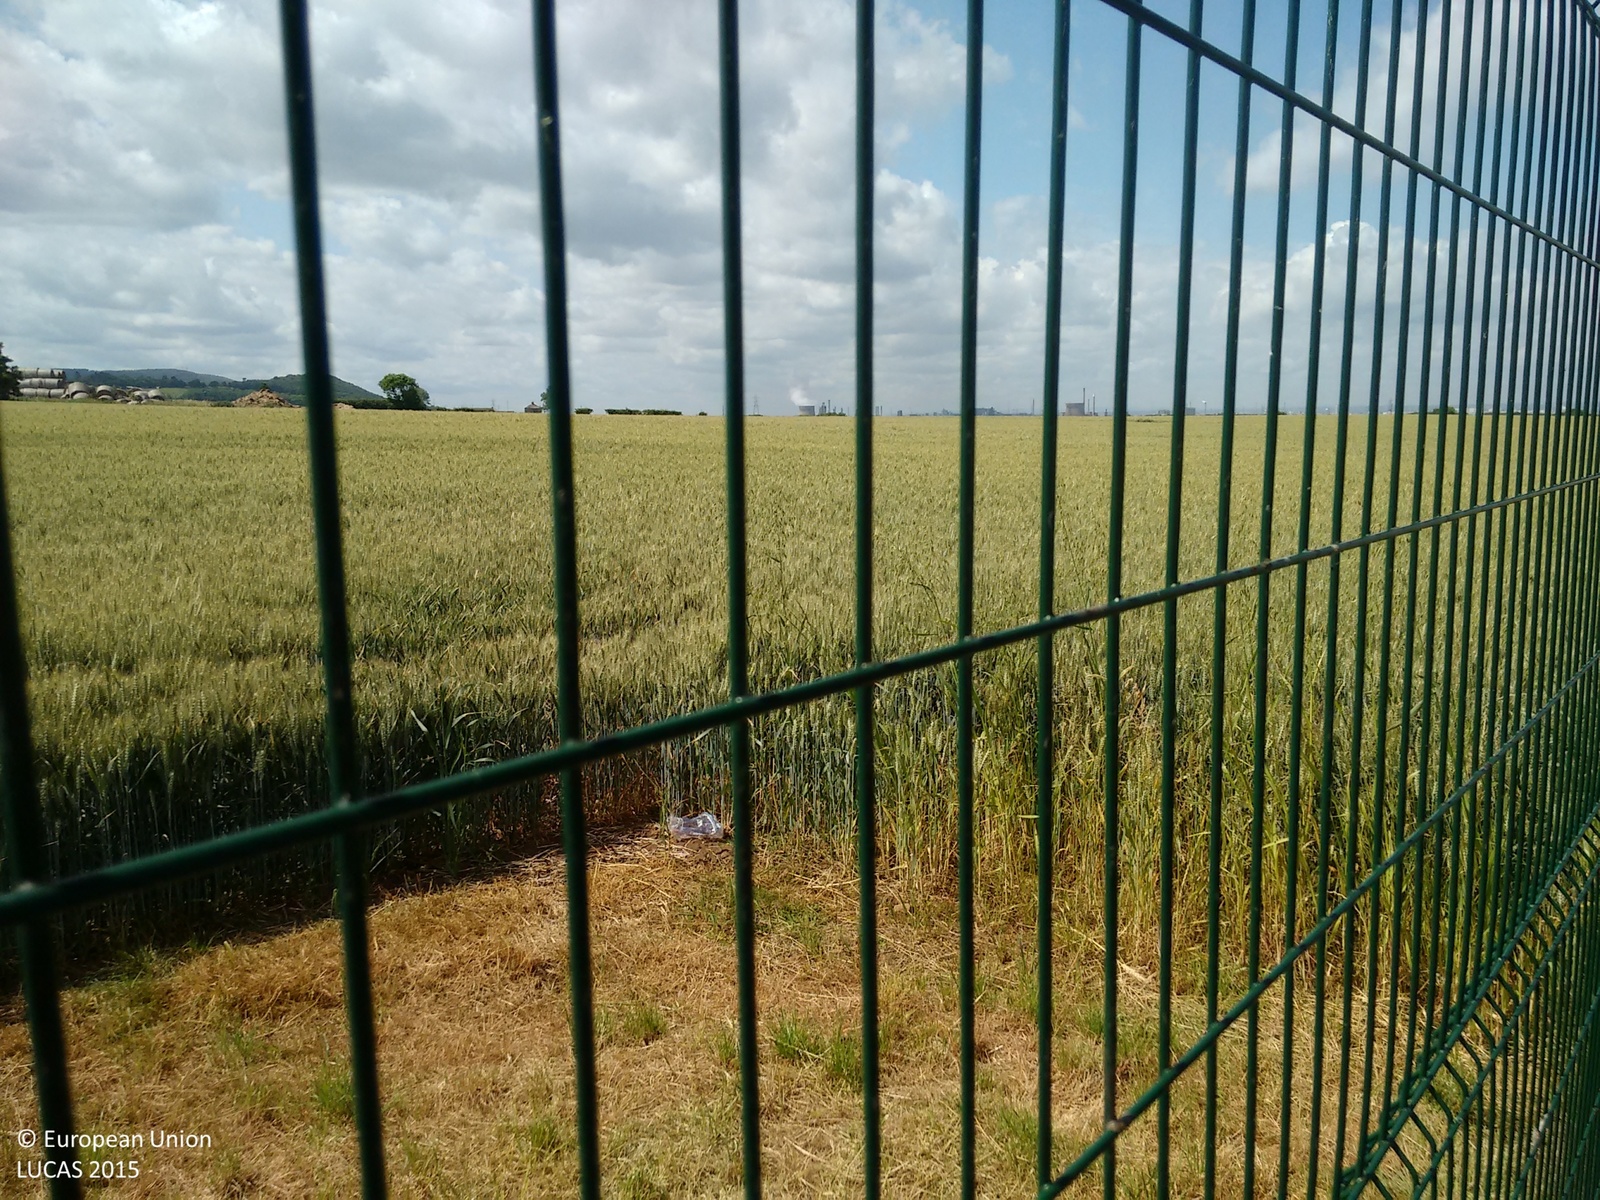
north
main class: Cropland
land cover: Common wheat
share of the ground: > 75 %
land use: Agriculture (excluding fallow land and kitchen gardens)
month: July
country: GB
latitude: 54.5836
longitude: -1.0434
